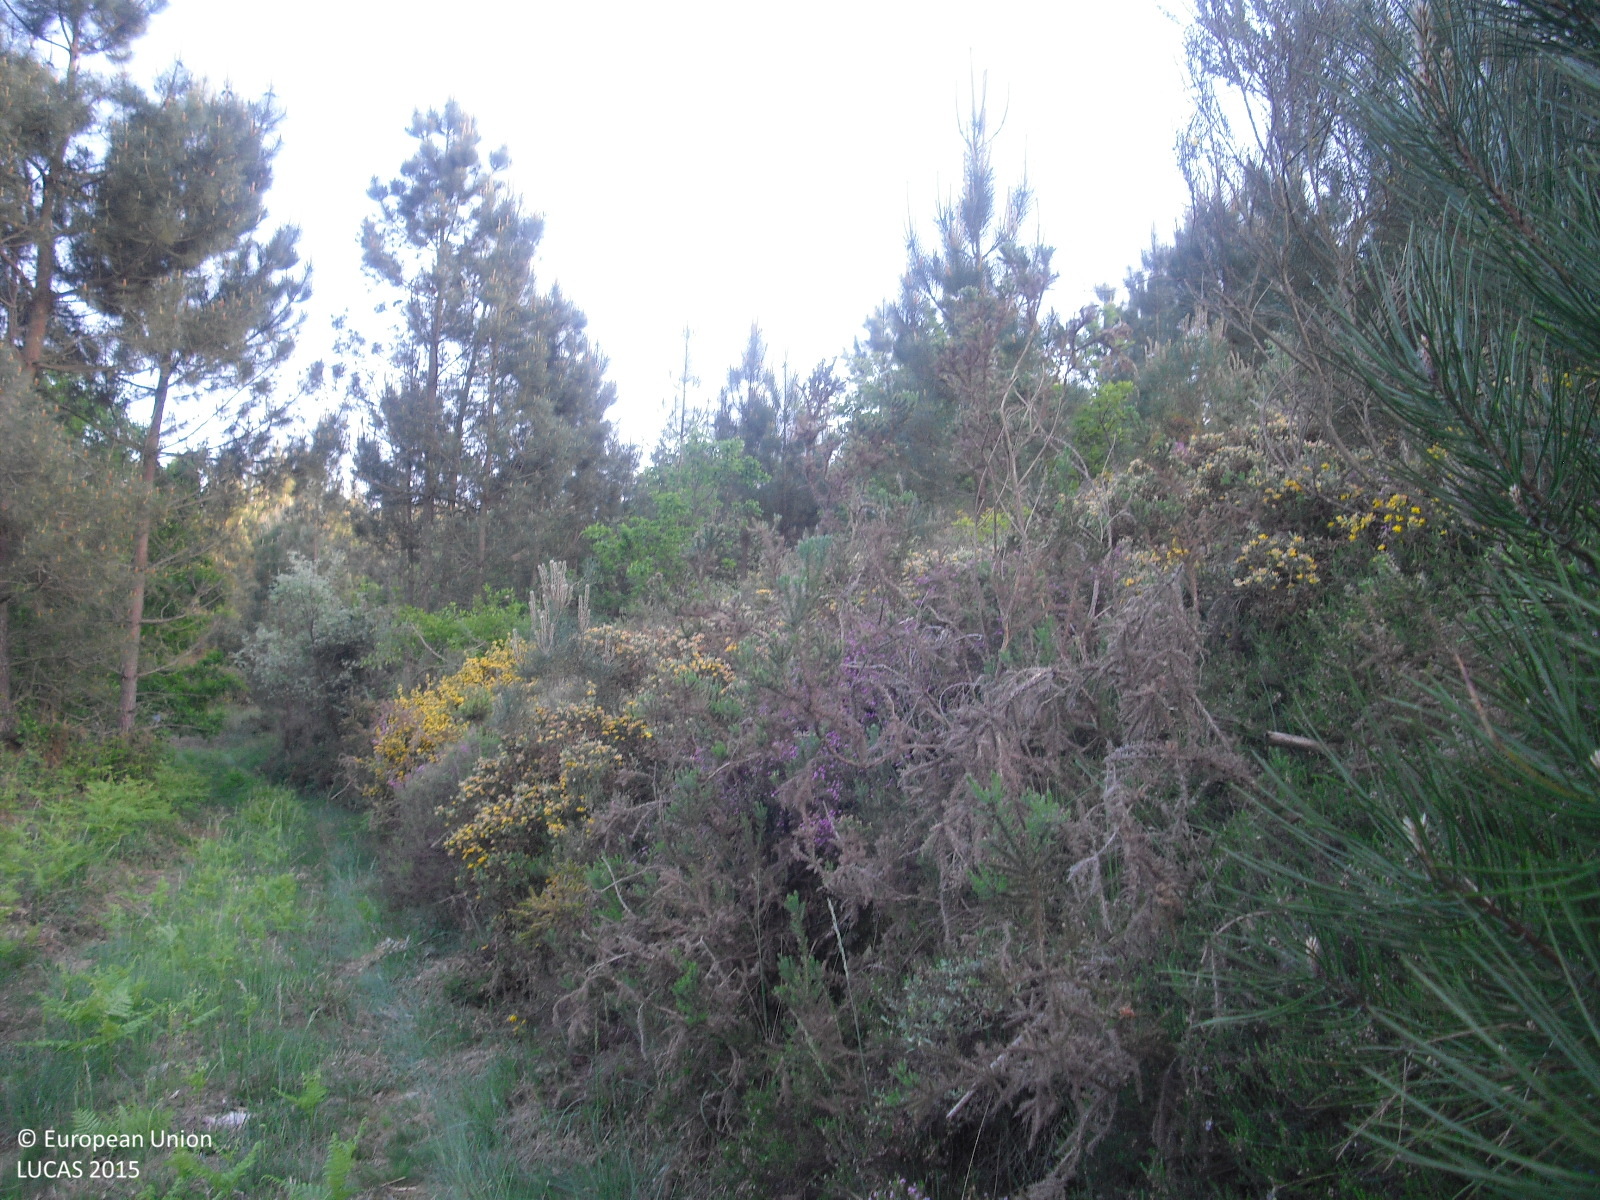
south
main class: Woodland
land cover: Pine dominated coniferous woodland
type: hemiboreal forest and nemoral coniferous forest and mixed broadleaved-coniferous forest
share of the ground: 10 - 25 %
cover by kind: shrubs 75 %, coniferous forest trees 25 %
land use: Forestry
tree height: < 5 m
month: May
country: ES
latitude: 42.0442
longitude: -7.5705
